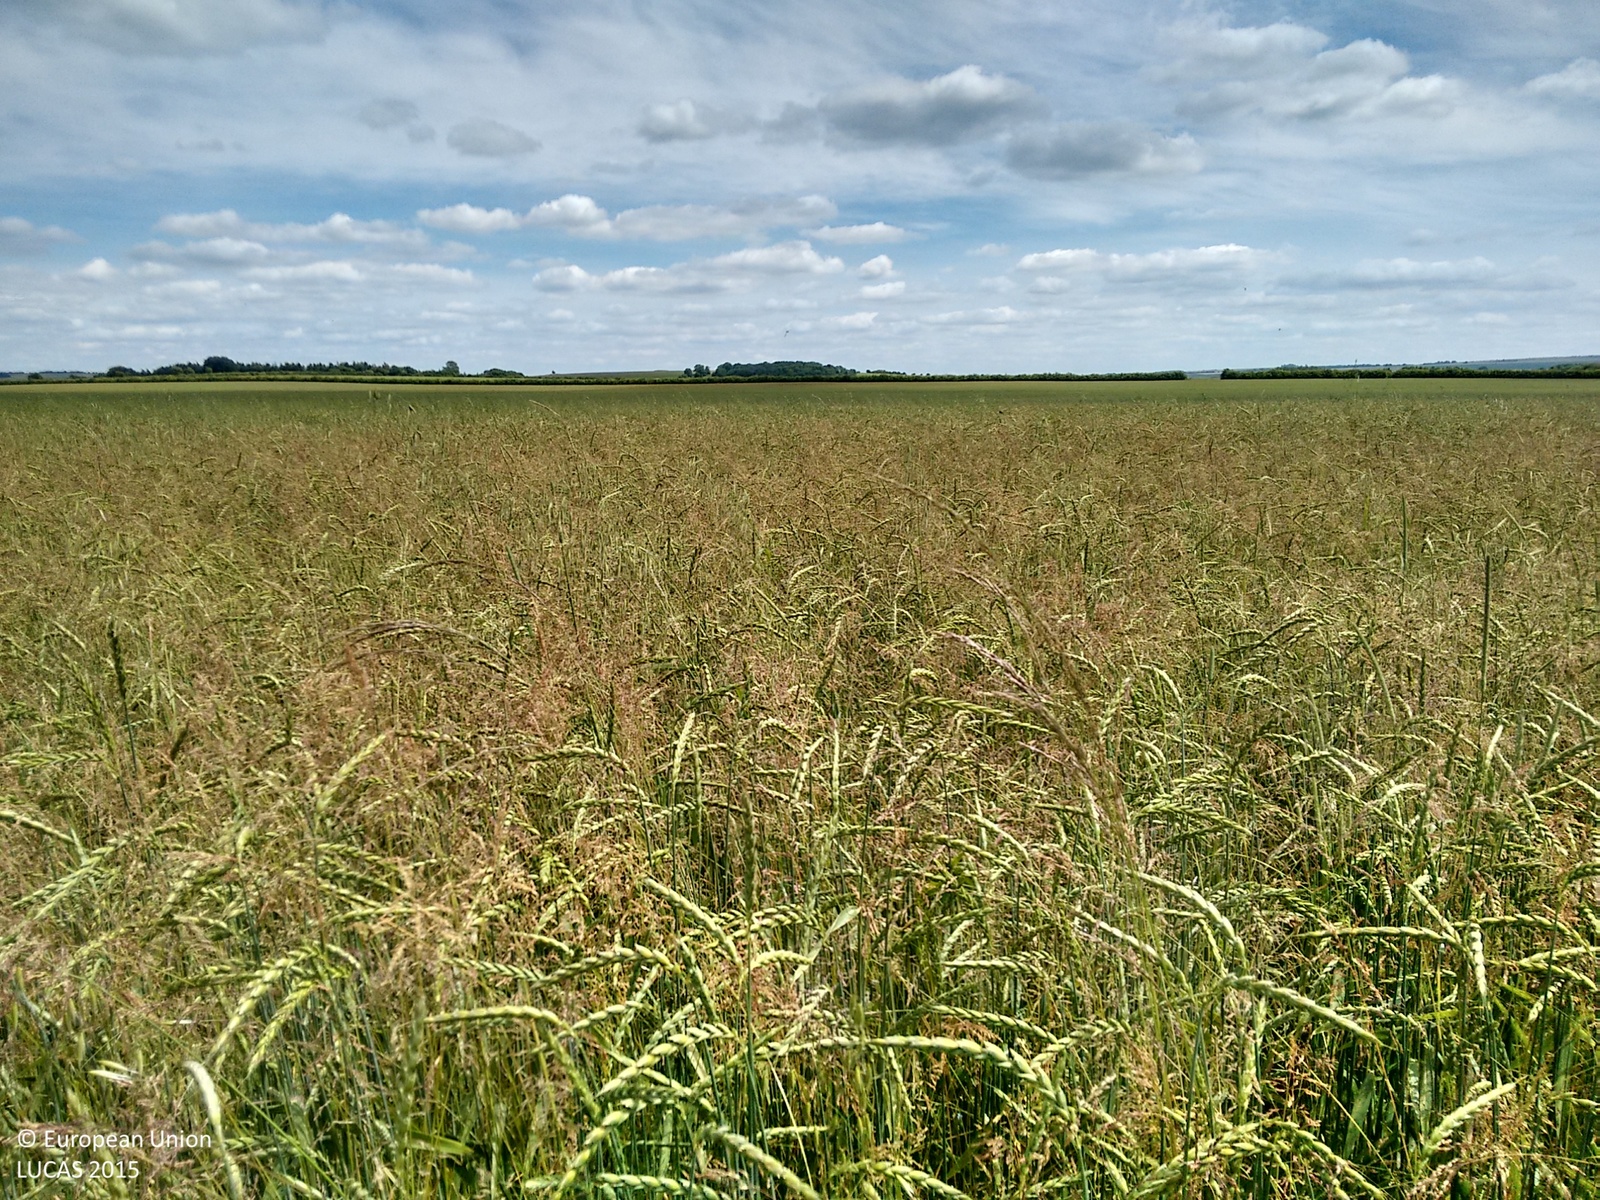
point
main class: Cropland
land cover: Mixed cereals for fodder
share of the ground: > 75 %
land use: Agriculture (excluding fallow land and kitchen gardens)
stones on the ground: < 10 %
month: June
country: GB
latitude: 51.4492
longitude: -1.8995
